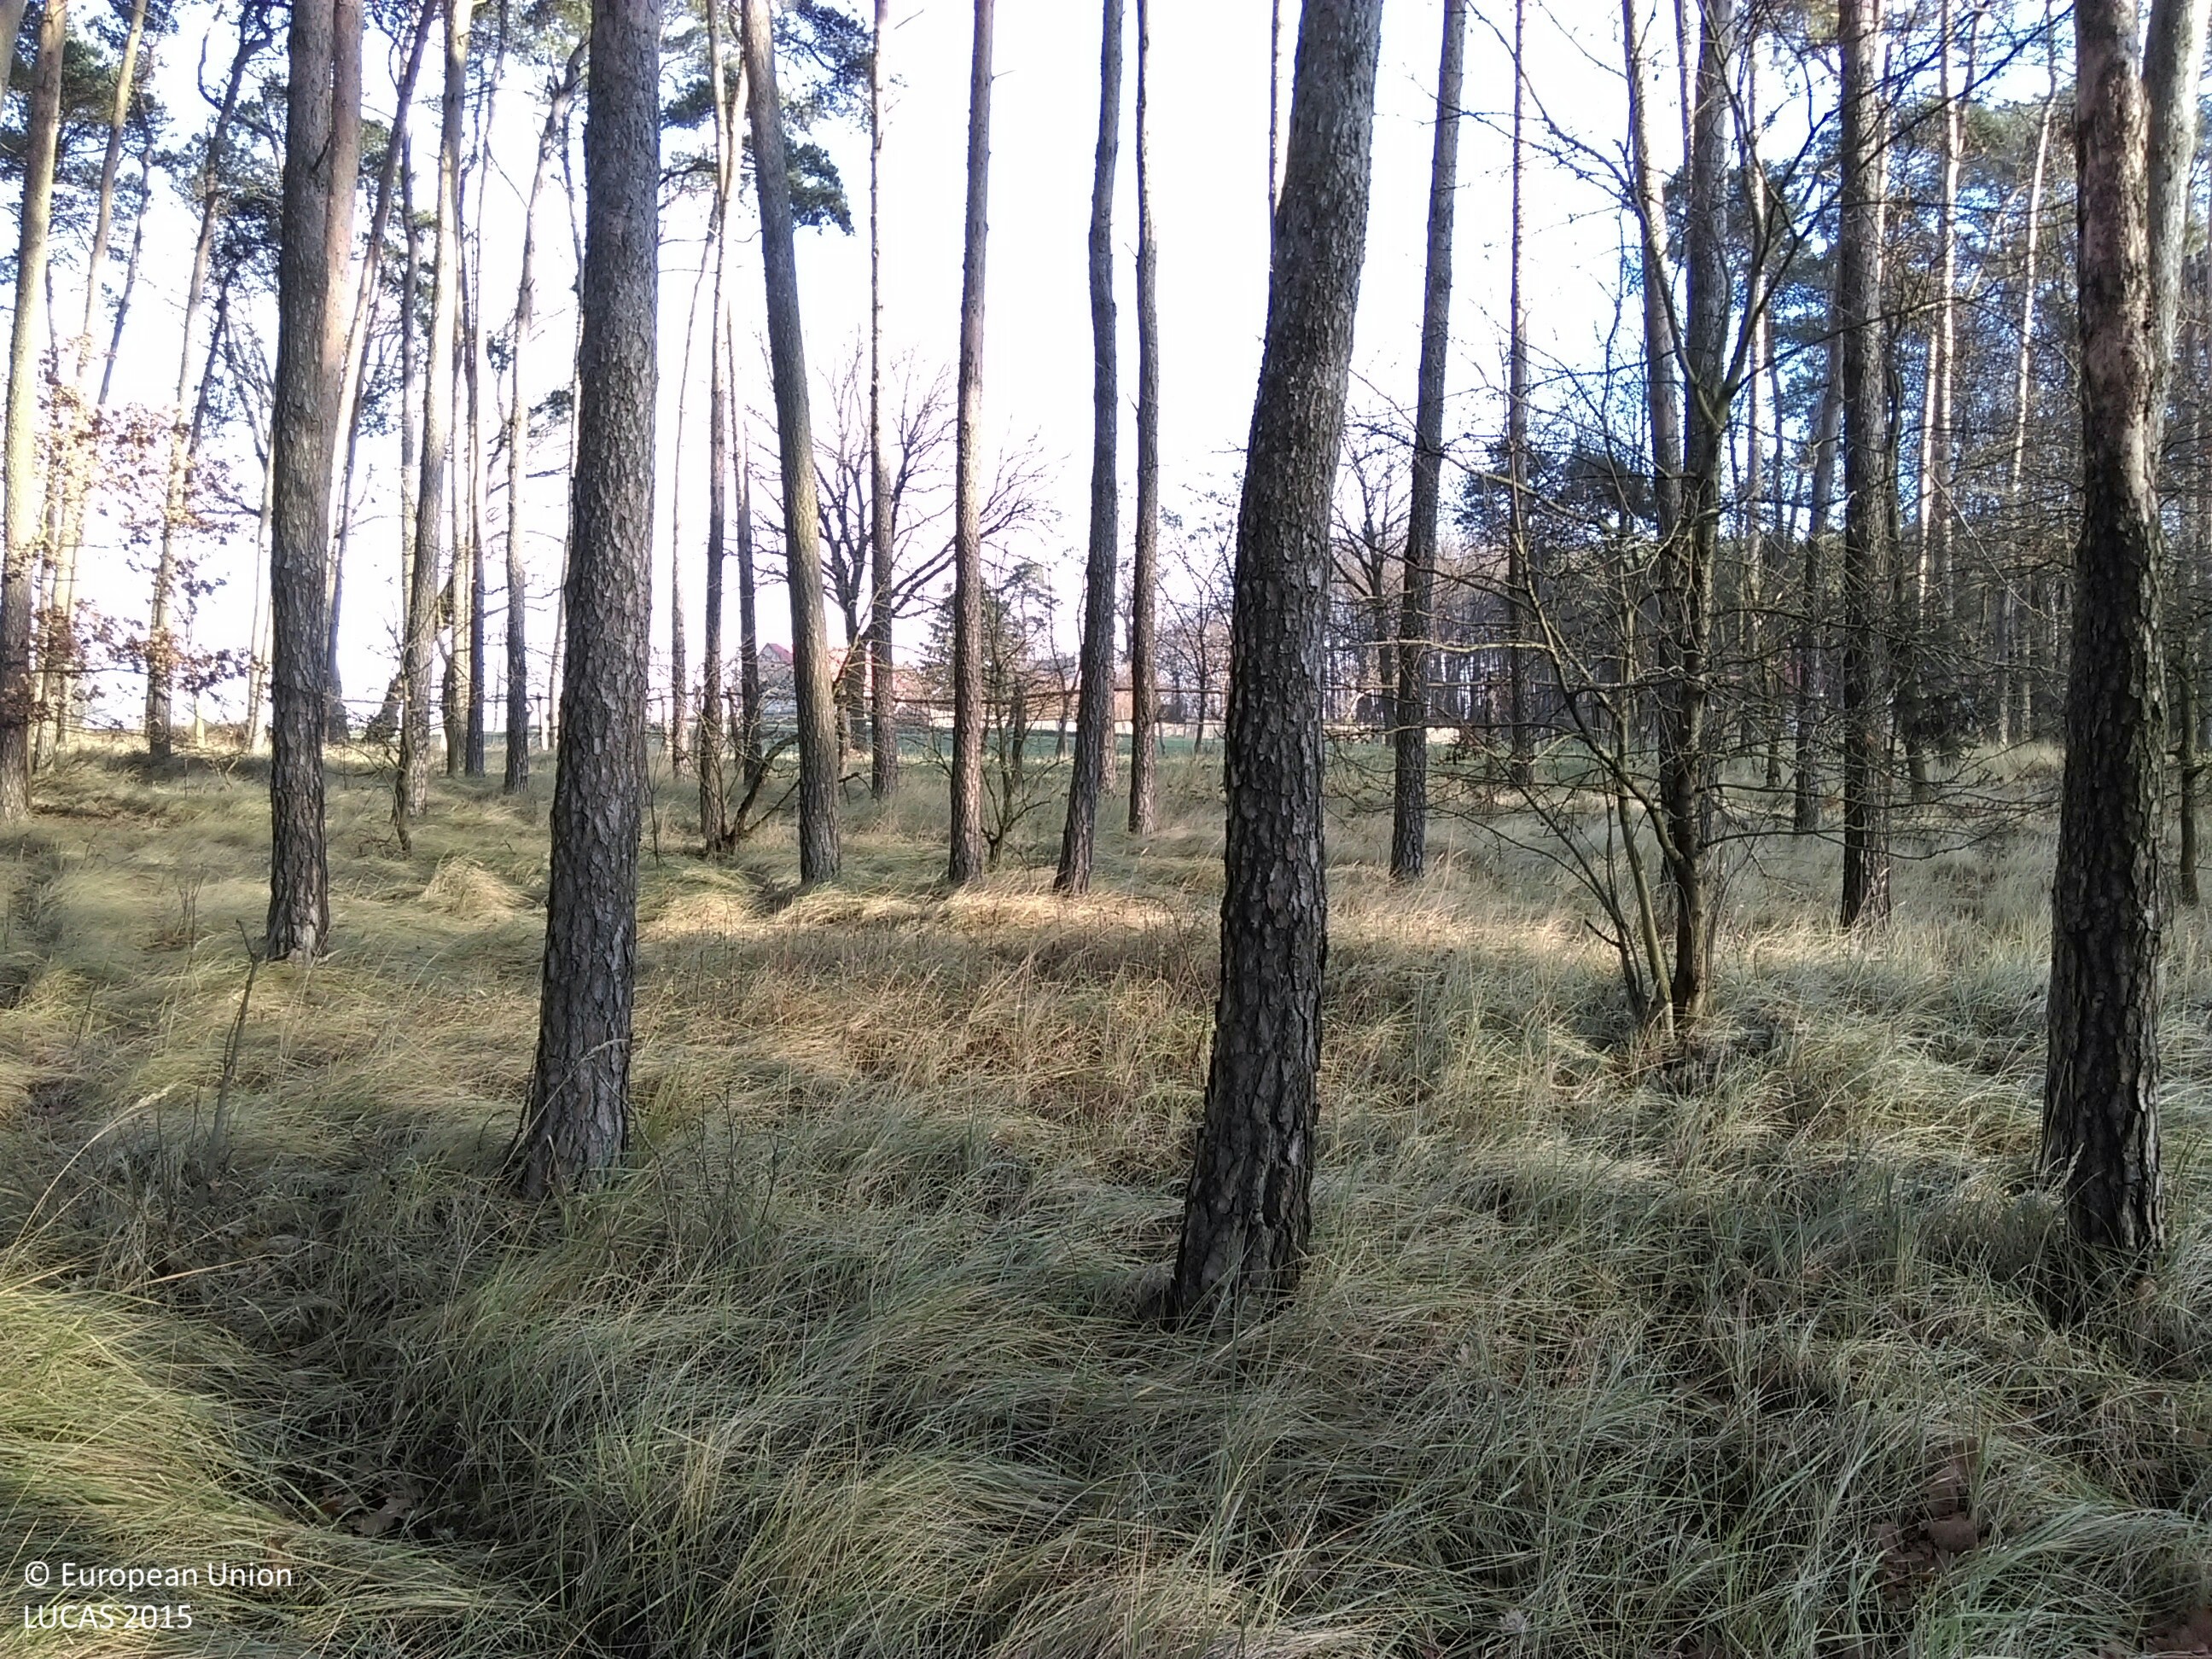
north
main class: Woodland
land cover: Pine dominated coniferous woodland
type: hemiboreal forest and nemoral coniferous forest and mixed broadleaved-coniferous forest
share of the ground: > 75 %
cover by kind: coniferous forest trees 75 %, herbaceous plants 25 %
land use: Forestry
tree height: > 5 m
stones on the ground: < 10 %
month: December
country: PL
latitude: 52.0724
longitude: 16.1777
